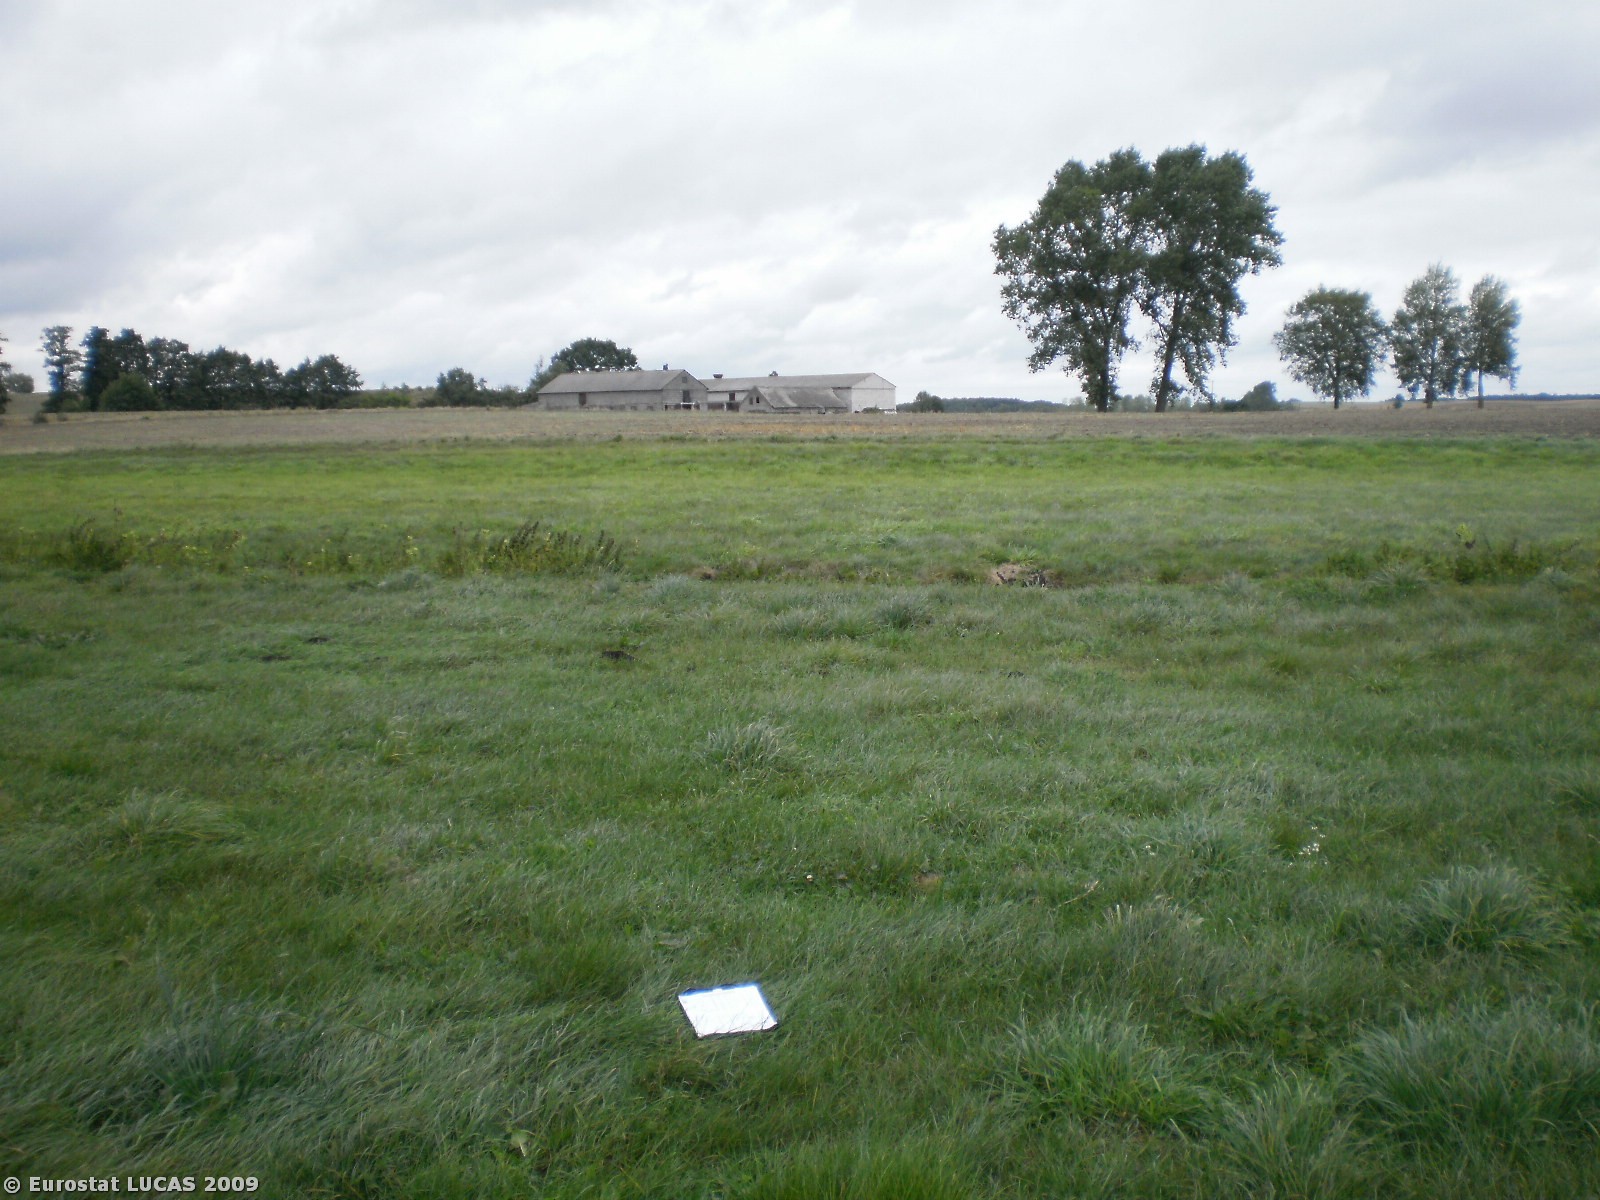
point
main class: Grassland
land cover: Grassland without tree/shrub cover
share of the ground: > 75 %
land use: Agriculture (excluding fallow land and kitchen gardens)
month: September
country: PL
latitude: 53.5899
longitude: 17.7025
